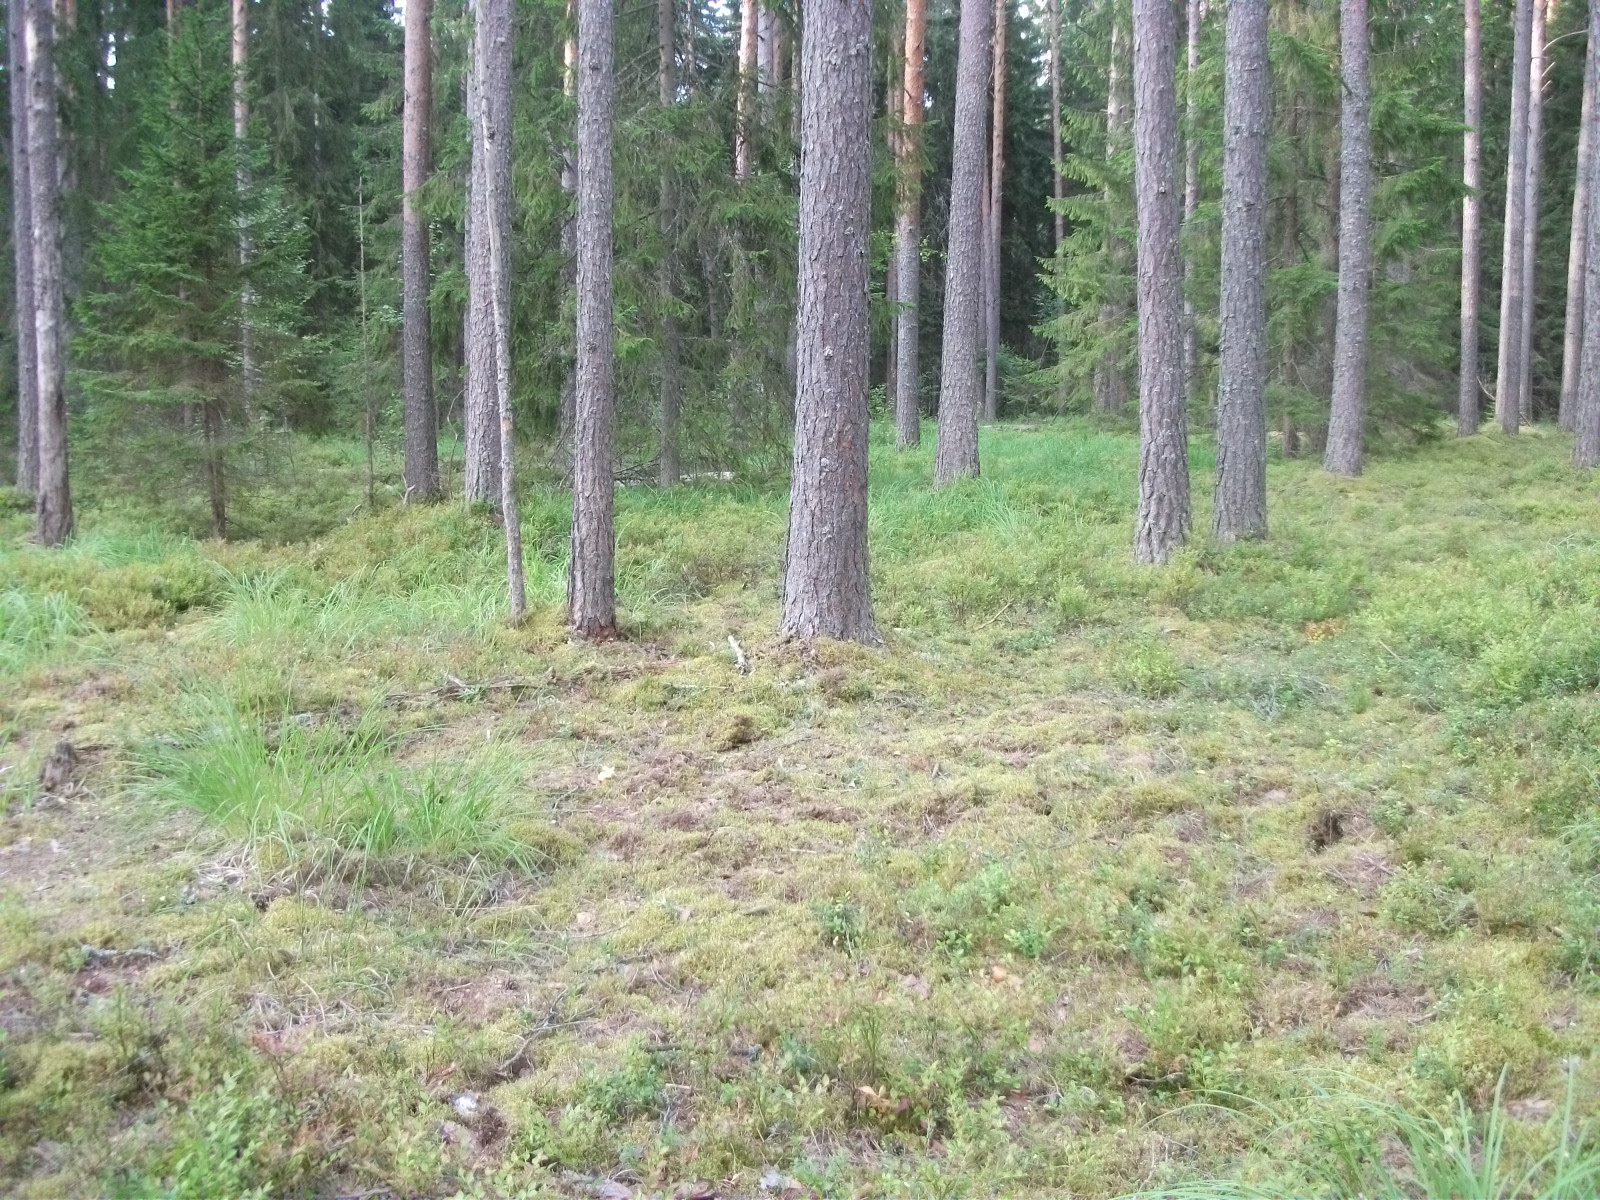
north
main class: Woodland
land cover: Other coniferous woodland
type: hemiboreal forest and nemoral coniferous forest and mixed broadleaved-coniferous forest
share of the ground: 50 - 75 %
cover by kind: coniferous forest trees 70 %, lichens and mosses 20 %, herbaceous plants 10 %
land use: Forestry
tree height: > 5 m
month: August
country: LV
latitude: 56.8533
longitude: 26.5287
